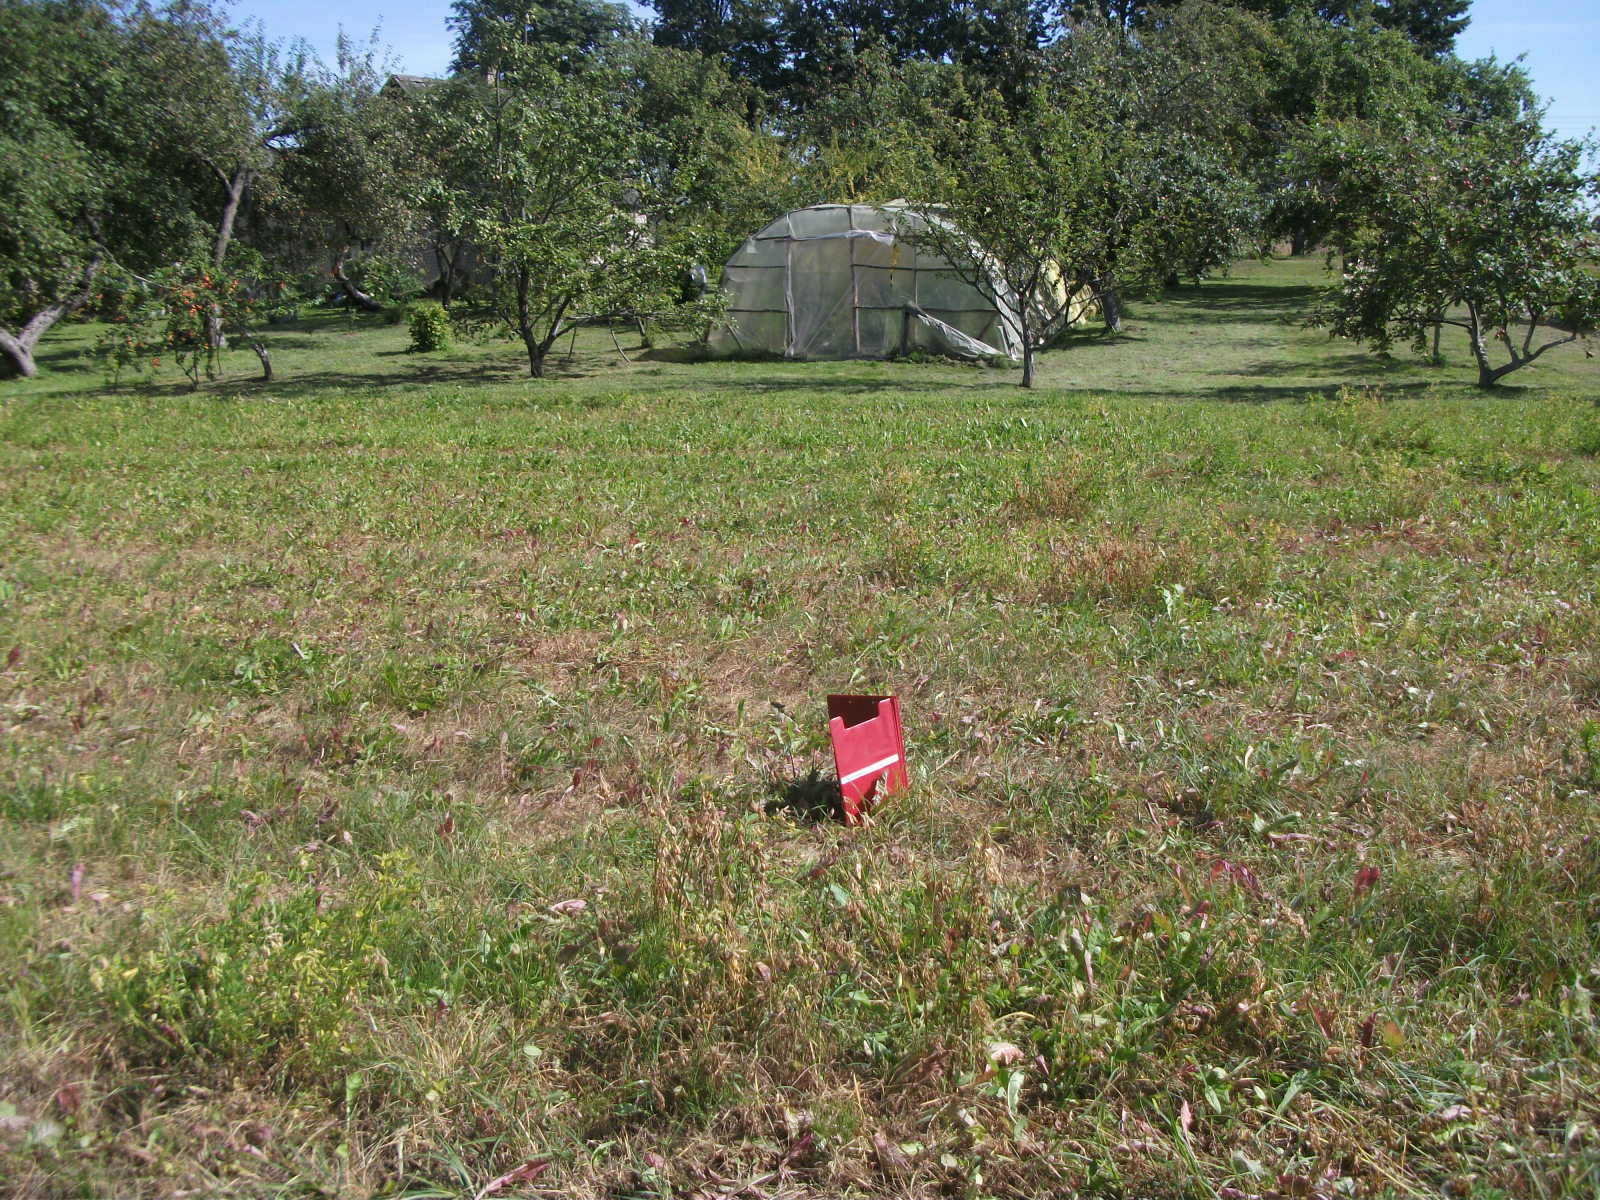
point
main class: Grassland
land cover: Grassland without tree/shrub cover
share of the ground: > 75 %
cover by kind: herbaceous plants 100 %
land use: Agriculture (excluding fallow land and kitchen gardens)
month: August
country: LV
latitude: 56.1828
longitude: 26.3029
